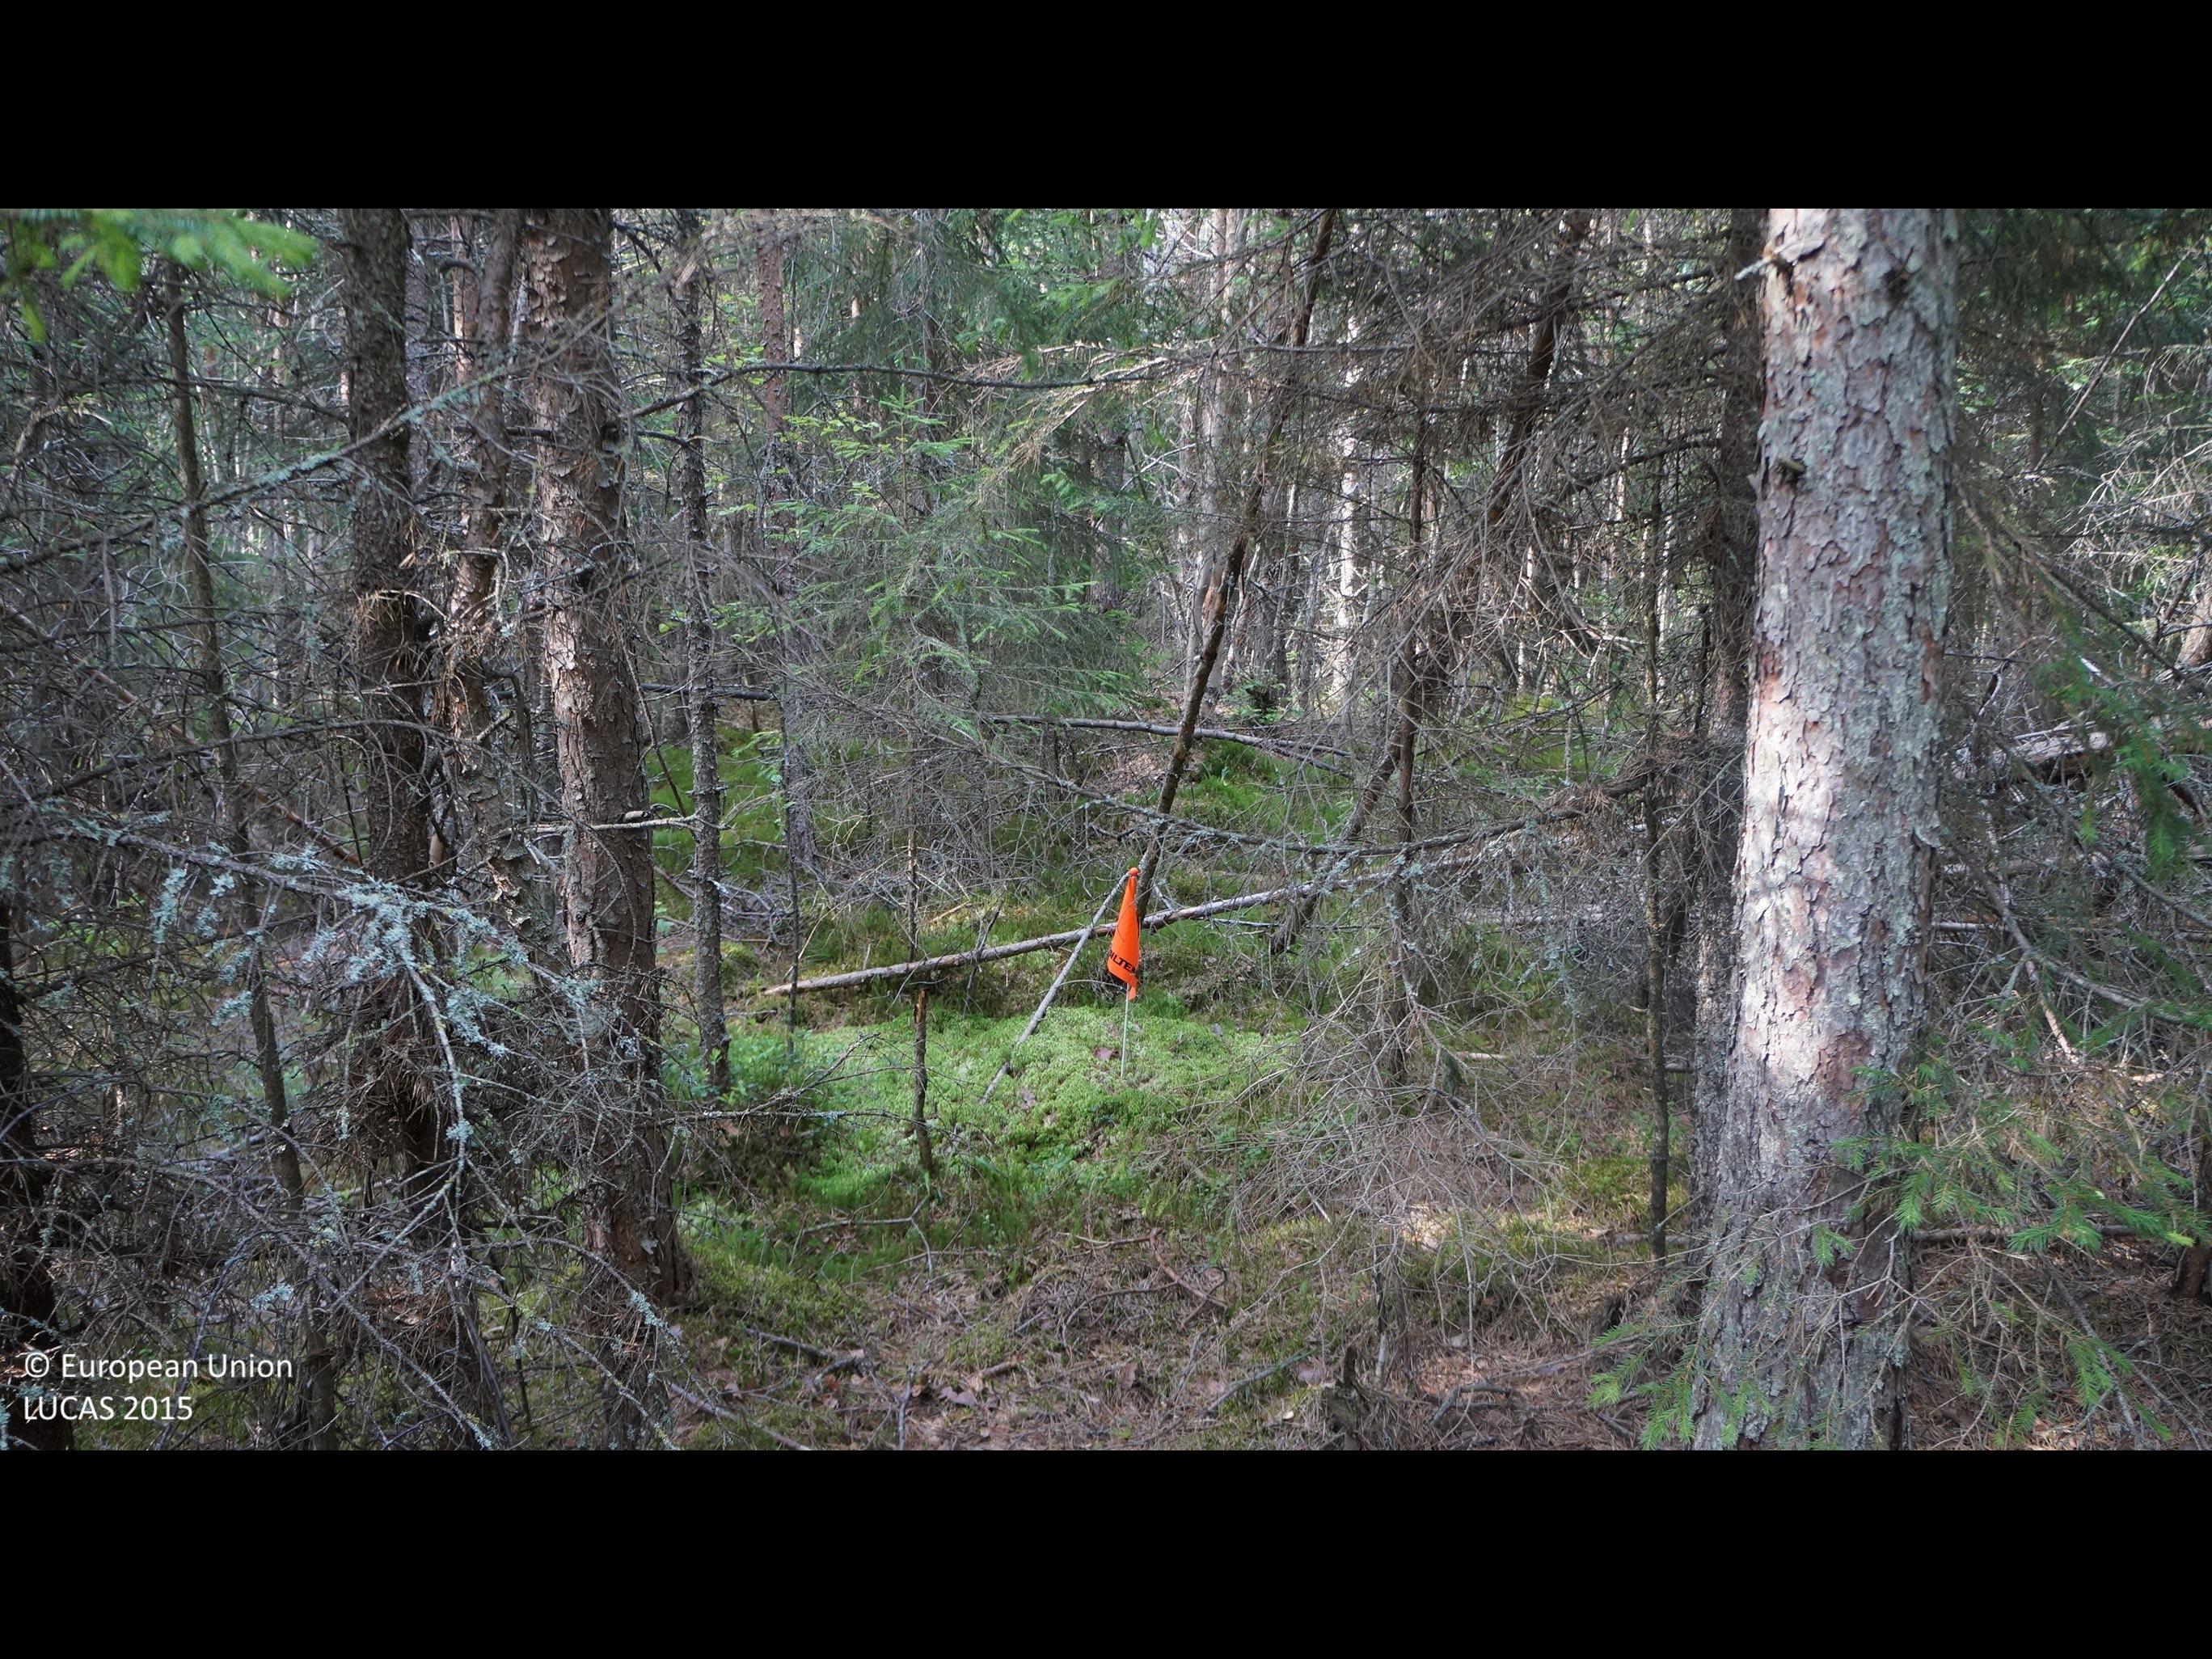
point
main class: Woodland
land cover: Pine dominated mixed woodland
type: boreal forest
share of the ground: > 75 %
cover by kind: coniferous forest trees 55 %, broadleaved forest trees 20 %, lichens and mosses 15 %, shrubs 10 %
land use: Forestry
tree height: > 5 m
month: July
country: FI
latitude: 64.7443
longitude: 24.6688
